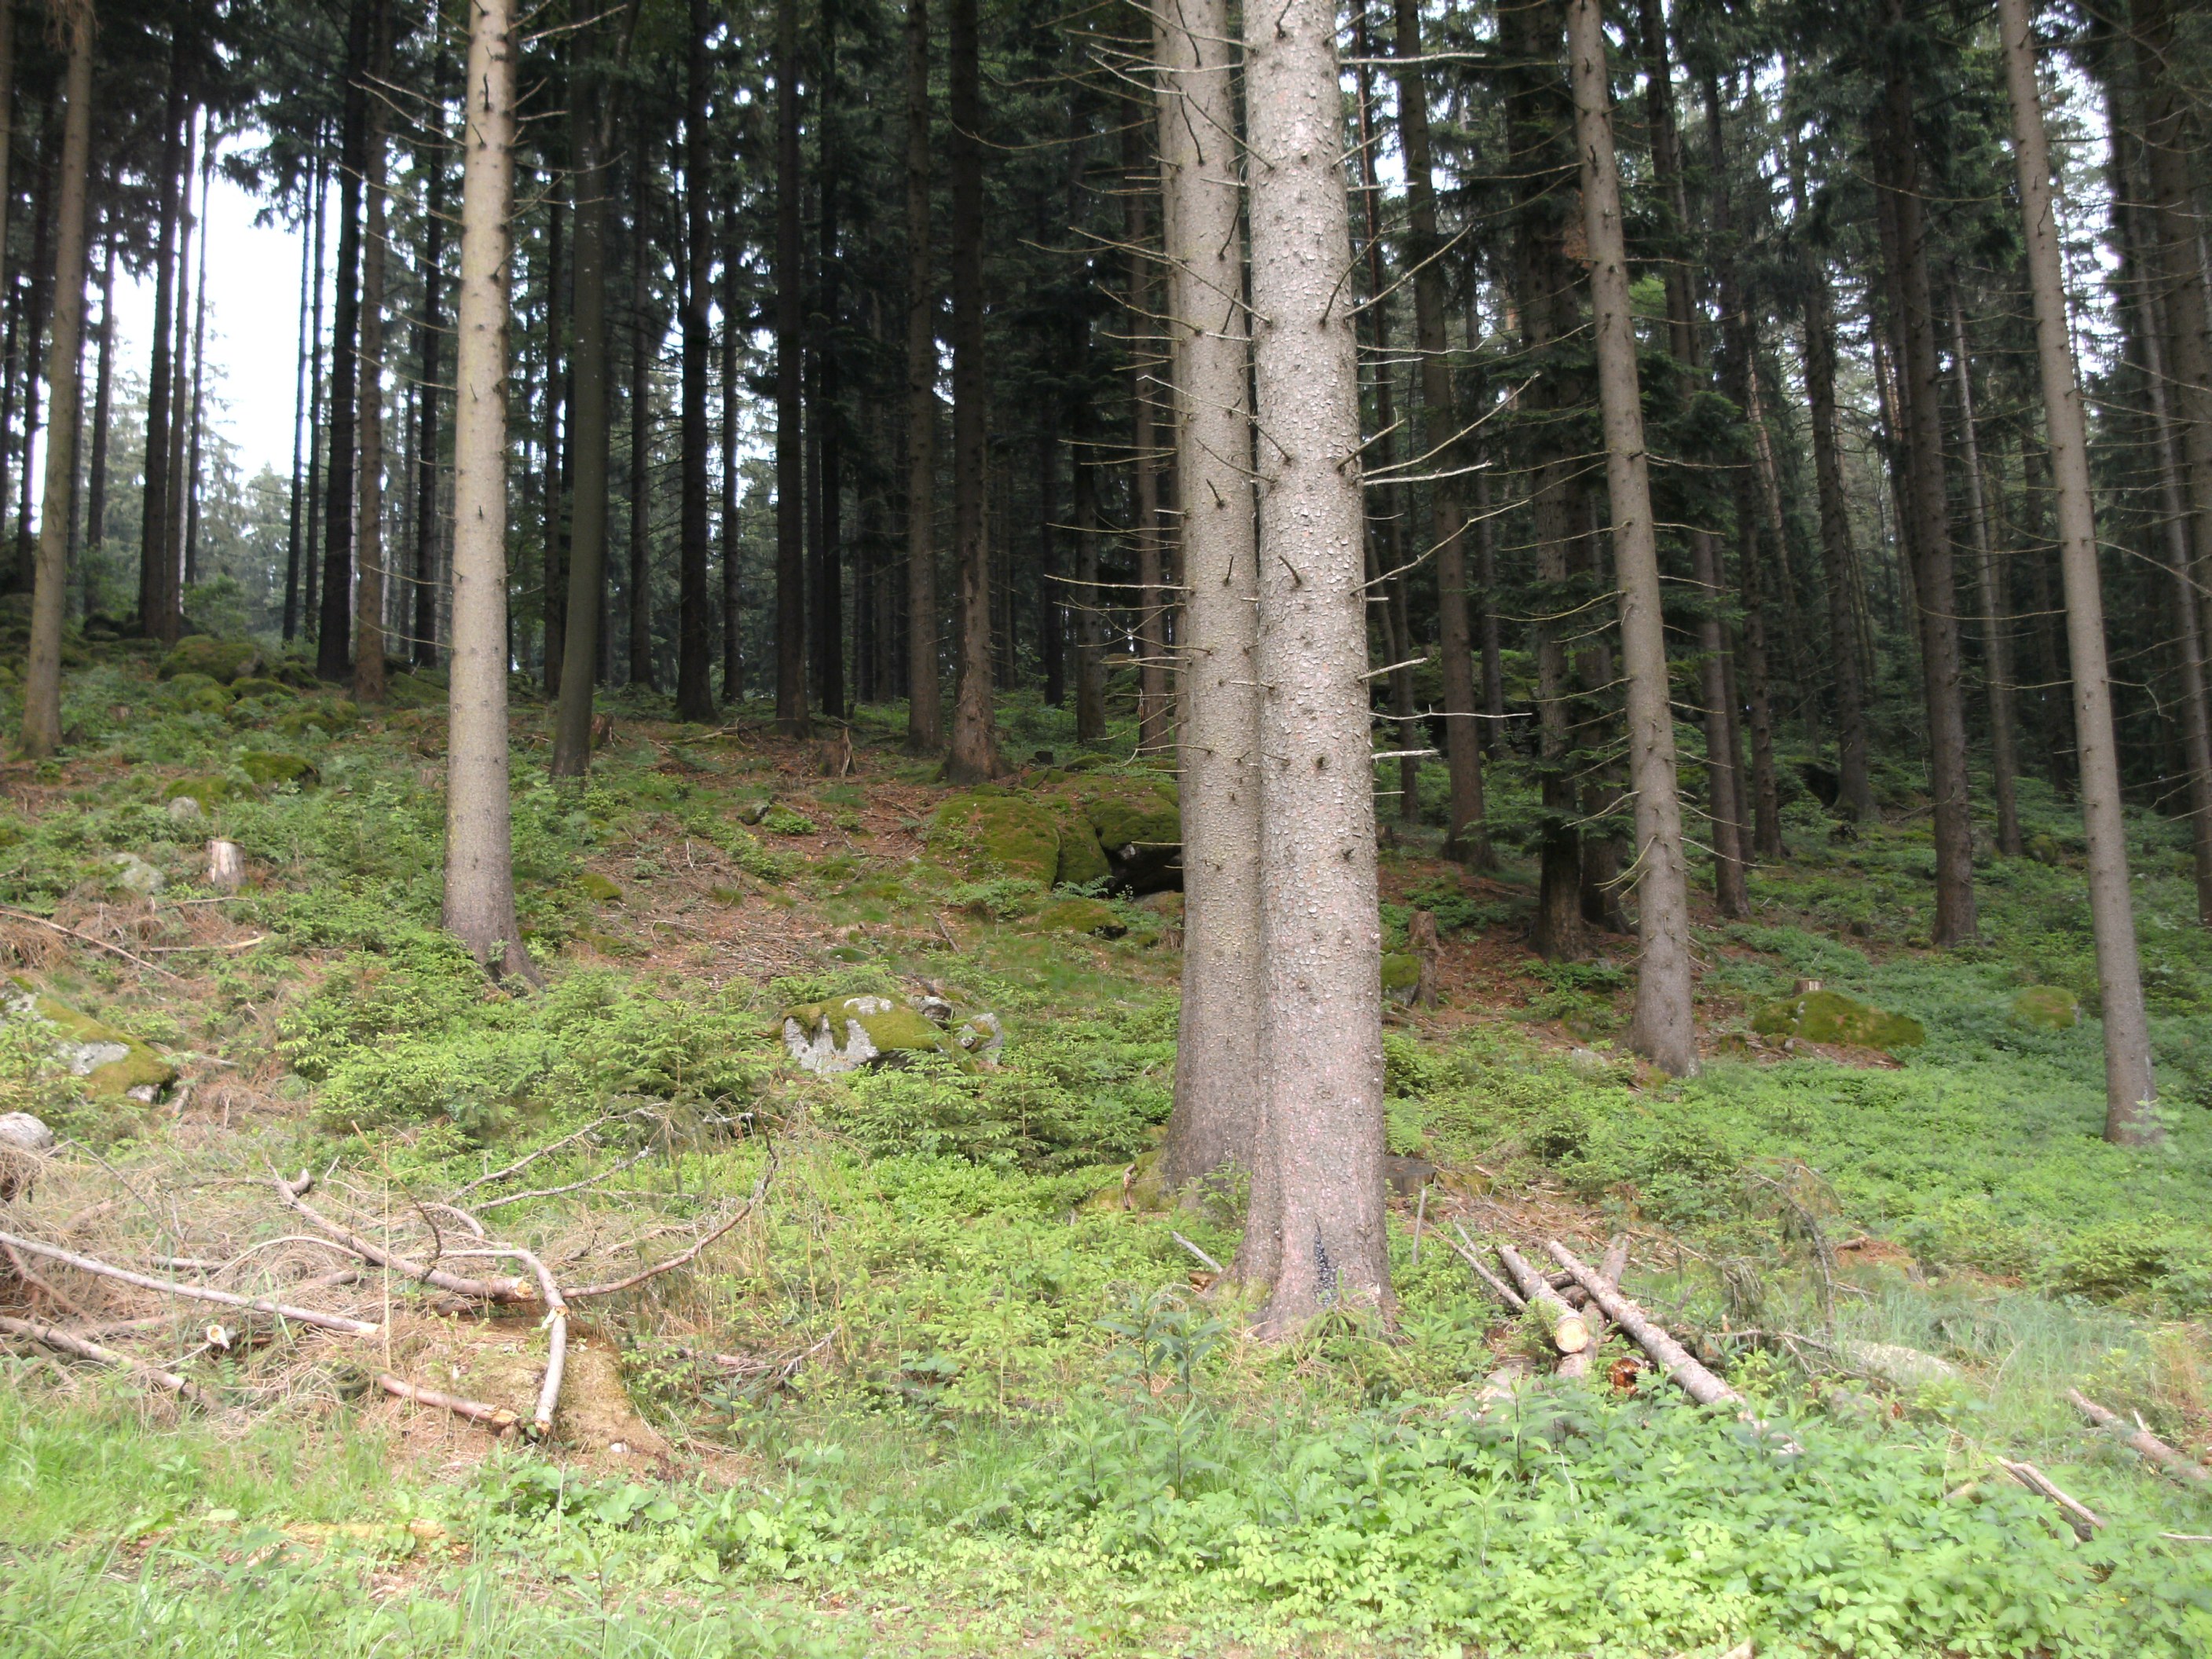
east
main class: Woodland
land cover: Spruce dominated coniferous woodland
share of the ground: 50 - 75 %
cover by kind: coniferous forest trees 65 %, herbaceous plants 10 %, lichens and mosses 10 %, consolidated bare surface 10 %, shrubs 5 %
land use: Forestry
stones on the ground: < 10 %
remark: Clear cut
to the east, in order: Spruce dominated coniferous woodland; Tracks; Spruce dominated coniferous woodland; Tracks; Spruce dominated coniferous woodland; Spruce dominated mixed woodland; Spruce dominated coniferous woodland; Ditches and canals; Spruce dominated coniferous woodland; Fences; Spruce dominated mixed woodland
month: June
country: AT
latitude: 48.5543
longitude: 14.2952
